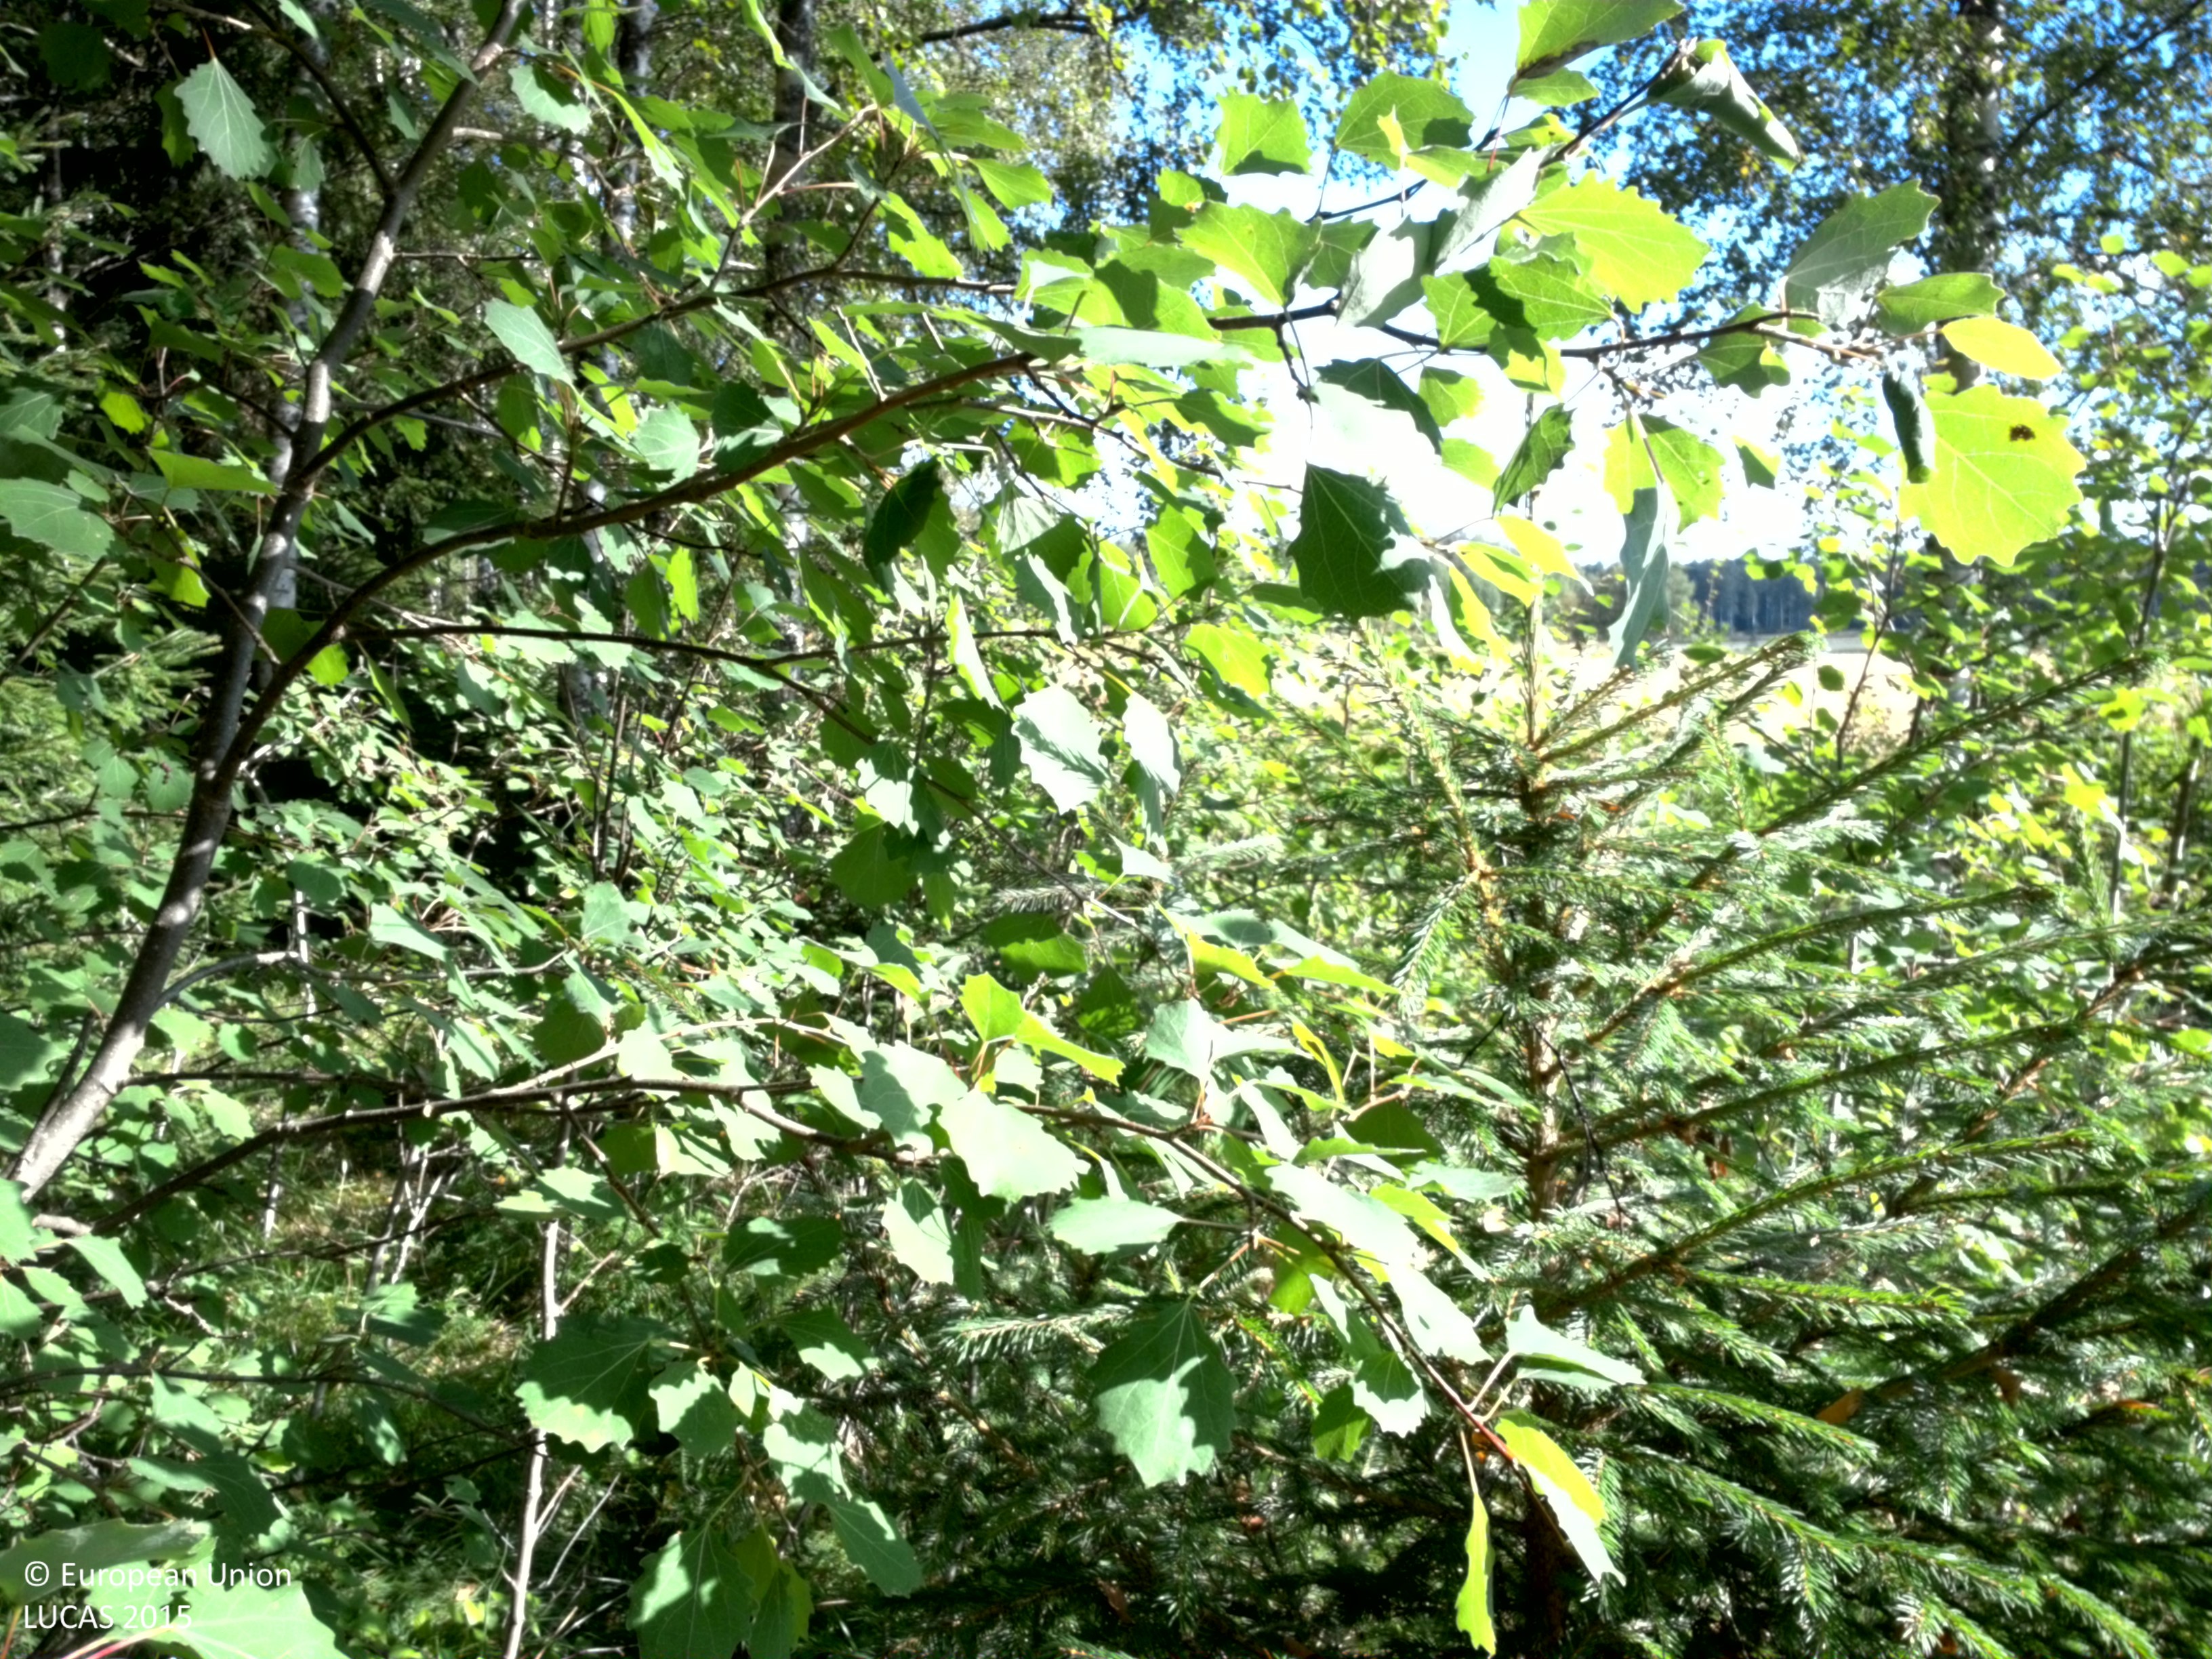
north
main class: Woodland
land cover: Spruce dominated mixed woodland
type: boreal forest
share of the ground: > 75 %
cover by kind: coniferous forest trees 60 %, broadleaved forest trees 20 %, herbaceous plants 20 %
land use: Forestry
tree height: > 5 m
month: August
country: SE
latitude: 59.9172
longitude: 16.9852
